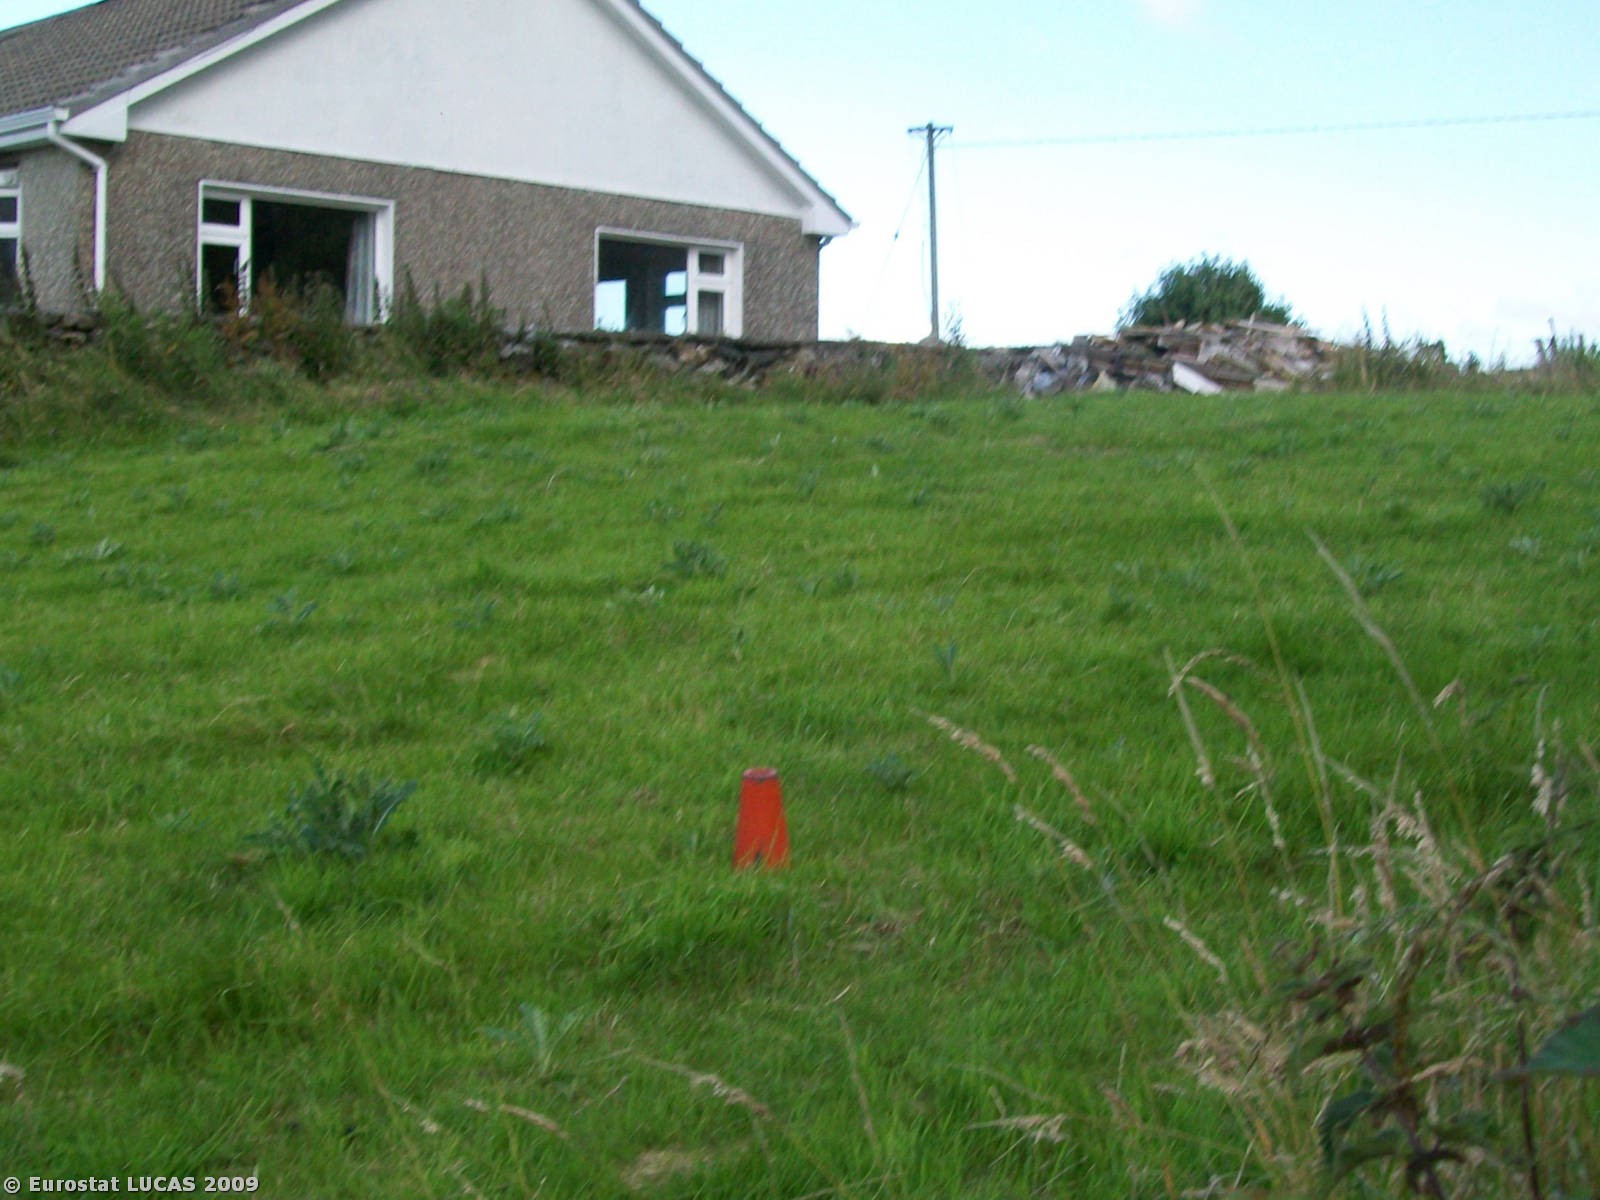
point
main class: Grassland
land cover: Grassland without tree/shrub cover
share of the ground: > 75 %
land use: Agriculture (excluding fallow land and kitchen gardens)
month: July
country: IE
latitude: 53.7643
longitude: -9.5772
